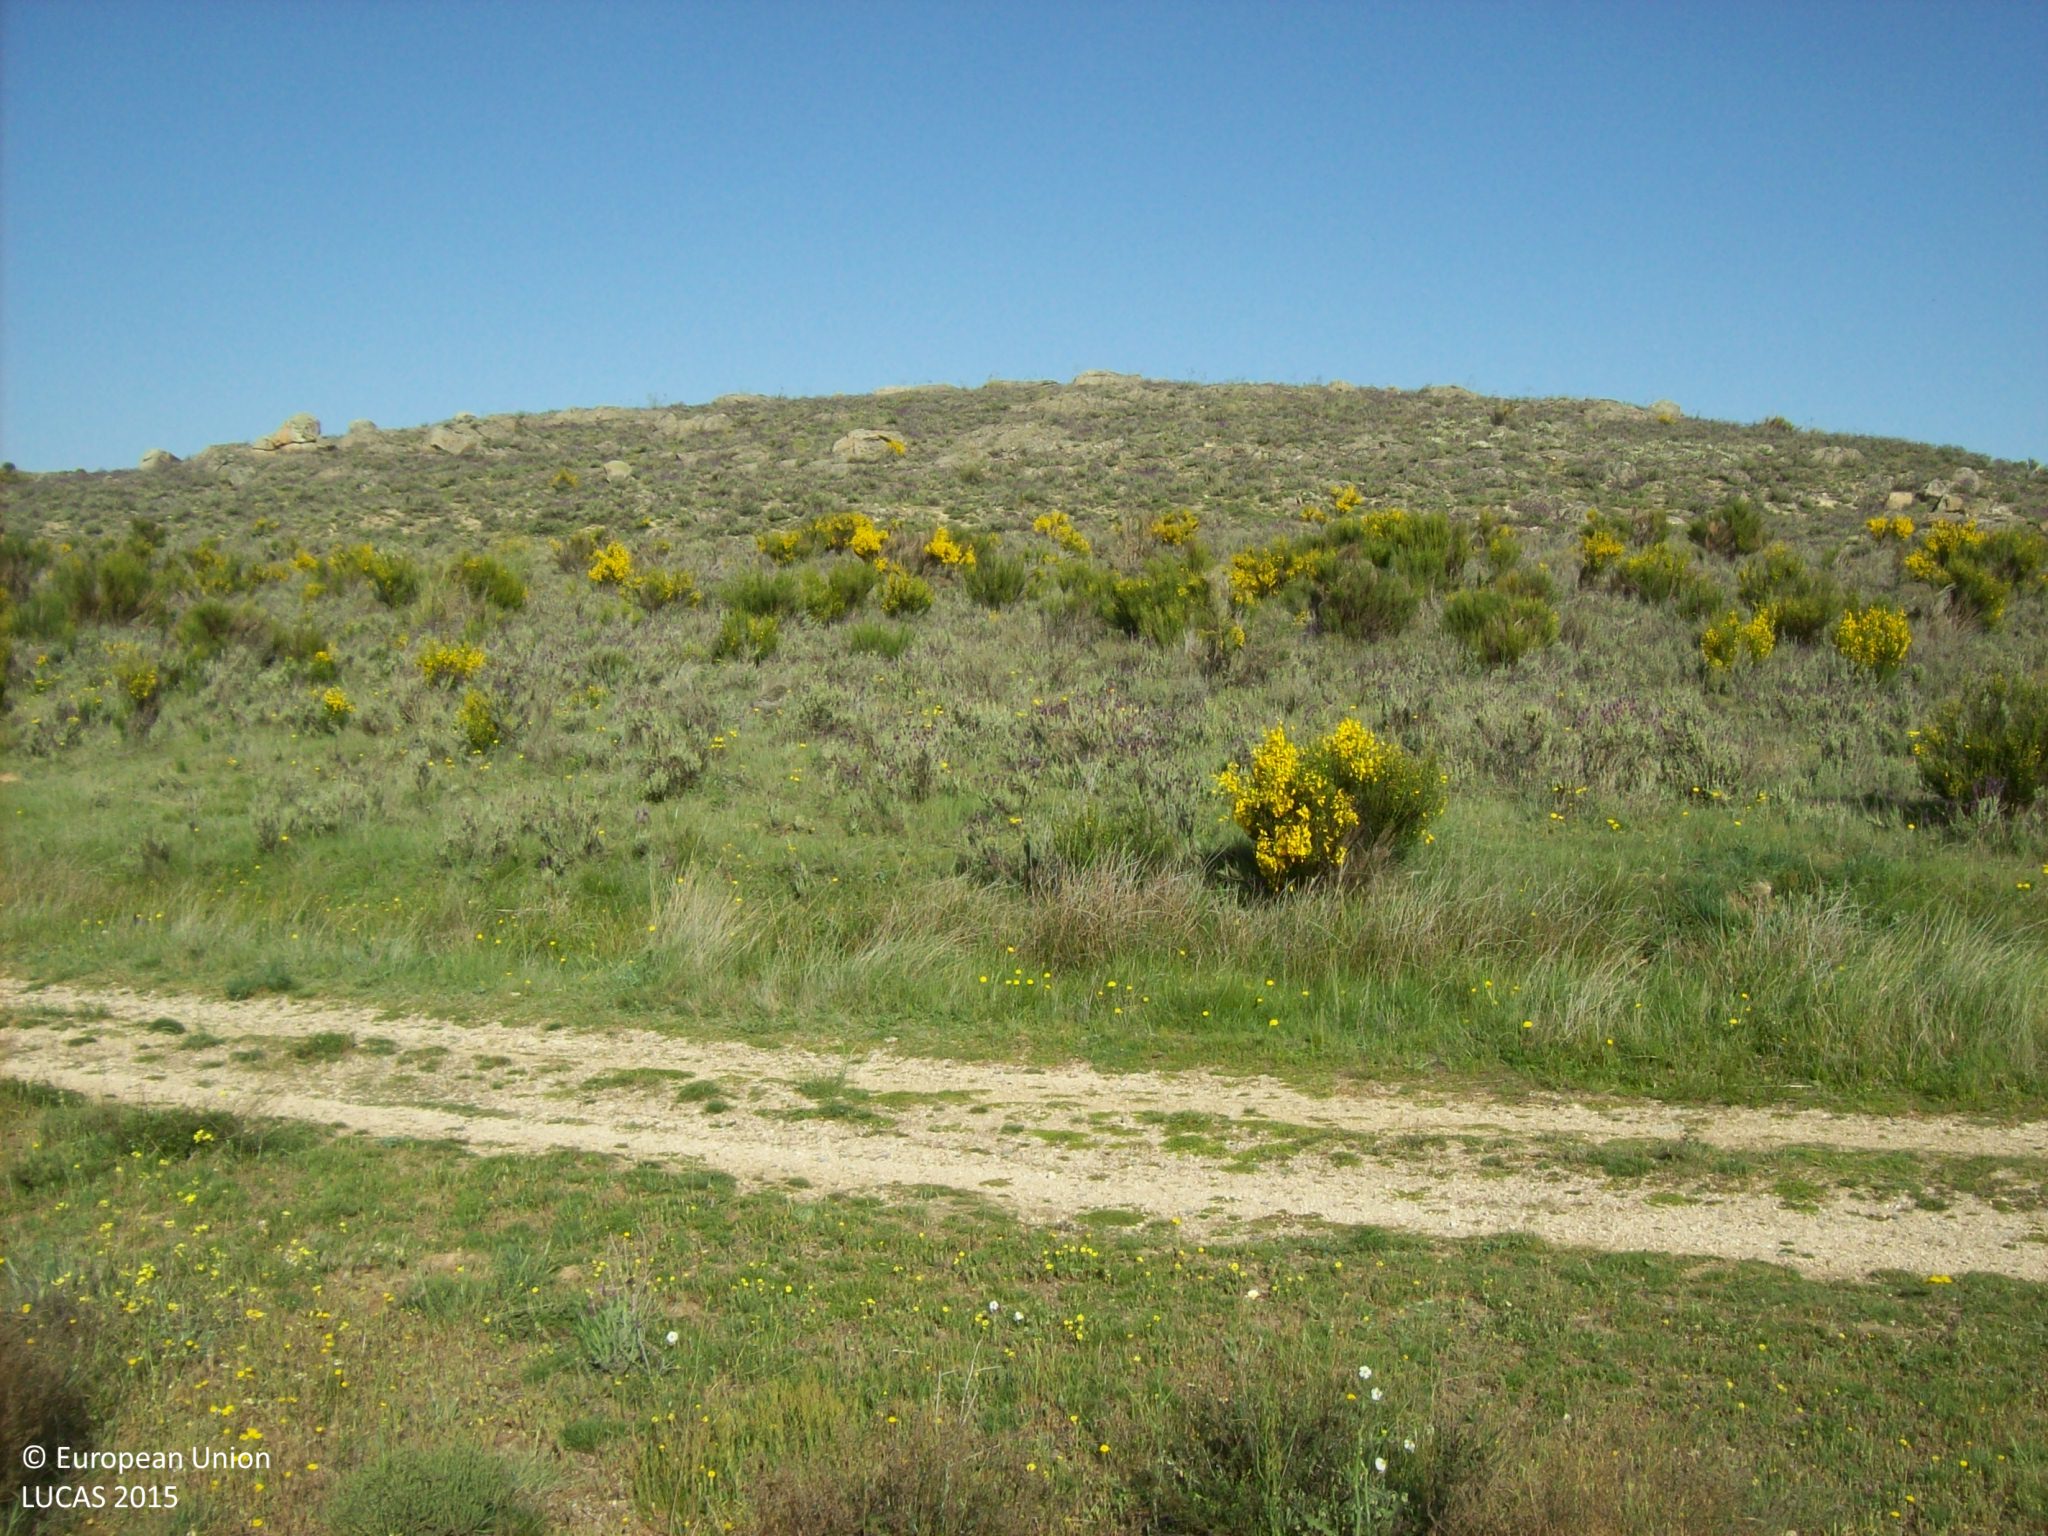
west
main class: Shrubland
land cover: Shrubland without tree cover
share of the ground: 50 - 75 %
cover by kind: shrubs 60 %, herbaceous plants 20 %, consolidated bare surface 5 %, unconsolidated bare surface 5 %
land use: Semi-natural and natural areas not in use
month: May
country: ES
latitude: 40.5470
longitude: -4.8280
